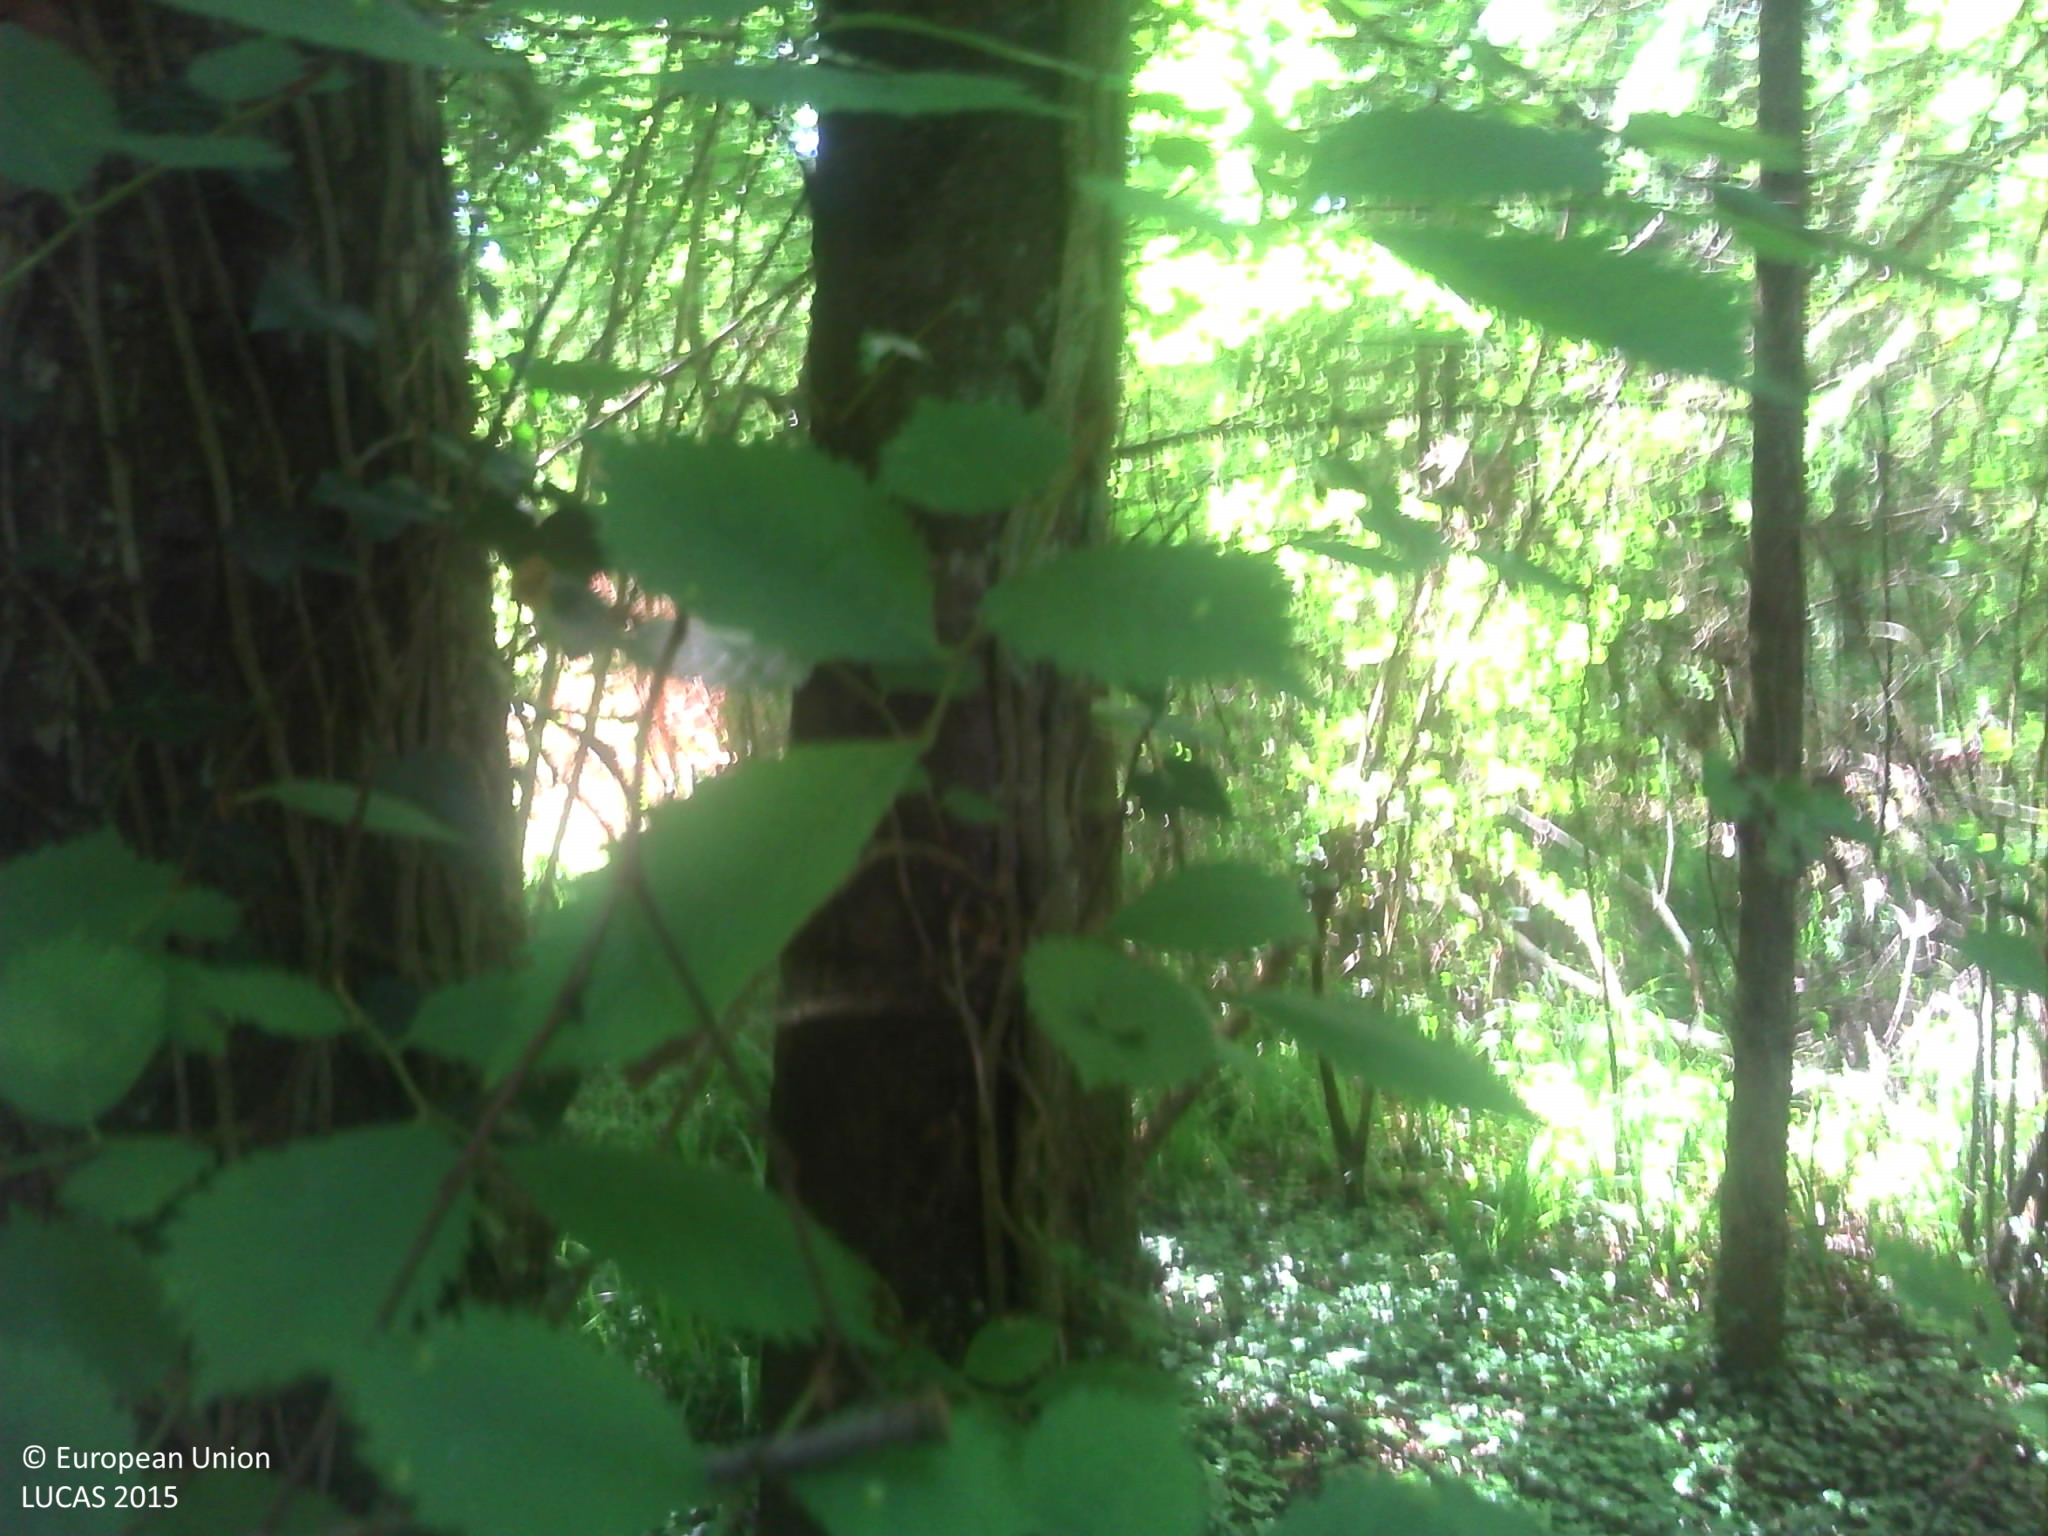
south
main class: Woodland
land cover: Broadleaved woodland
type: mesophytic deciduous forest
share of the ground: > 75 %
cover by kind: broadleaved forest trees 90 %, herbaceous plants 10 %
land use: Forestry
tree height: > 5 m
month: June
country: FR
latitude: 48.4419
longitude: 4.7664
